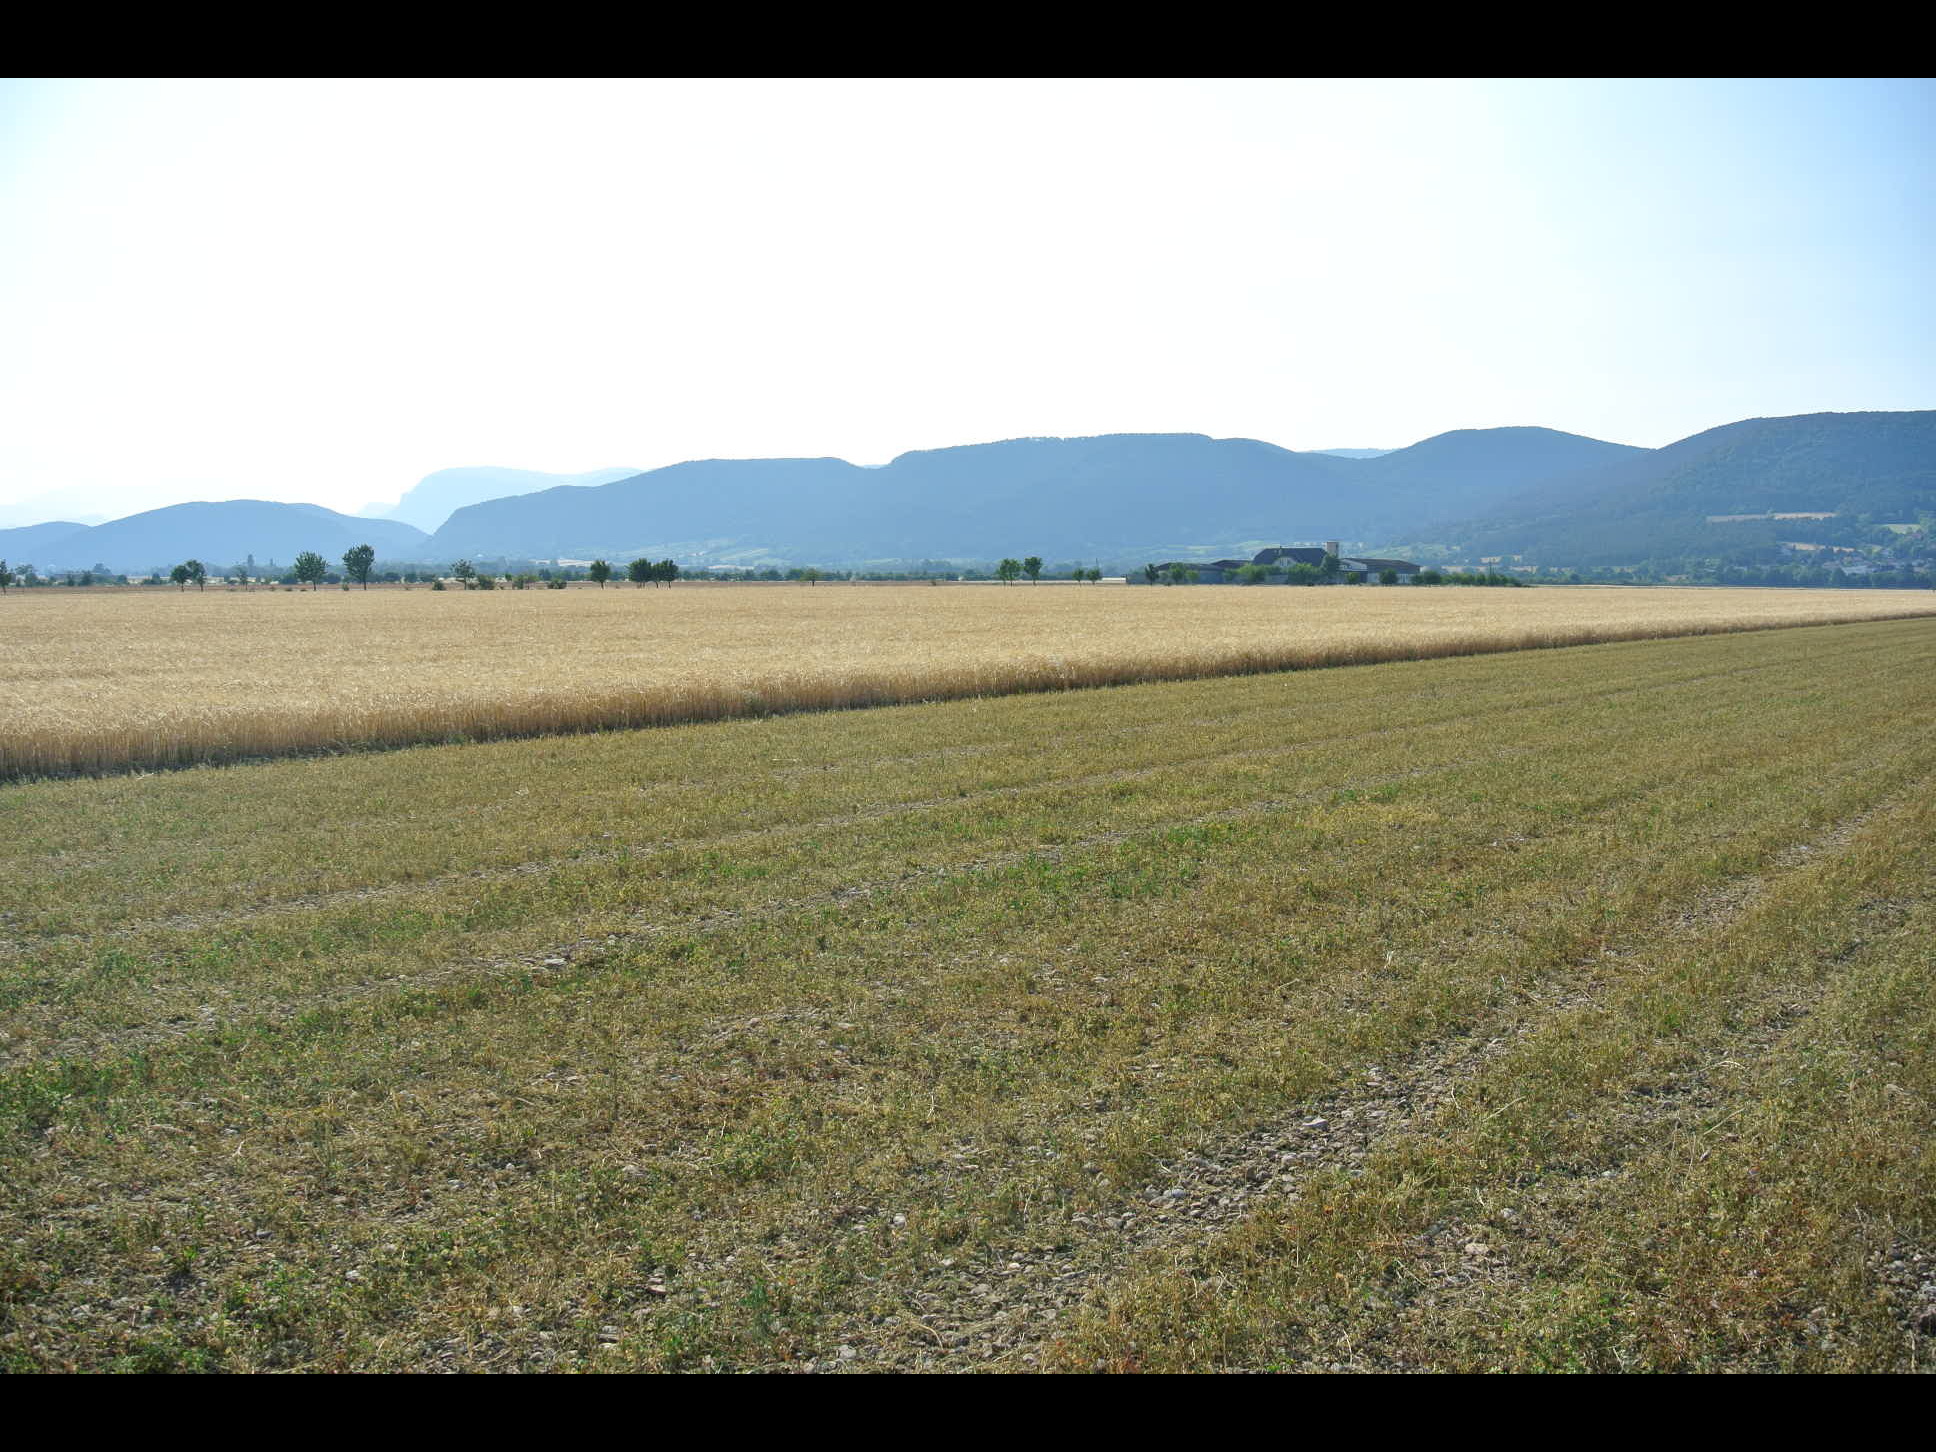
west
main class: Grassland
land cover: Grassland without tree/shrub cover
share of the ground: > 75 %
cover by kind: herbaceous plants 80 %, unconsolidated bare surface 20 %
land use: Agriculture (excluding fallow land and kitchen gardens)
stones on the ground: > 50 %
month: July
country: AT
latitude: 47.8166
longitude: 16.1603
